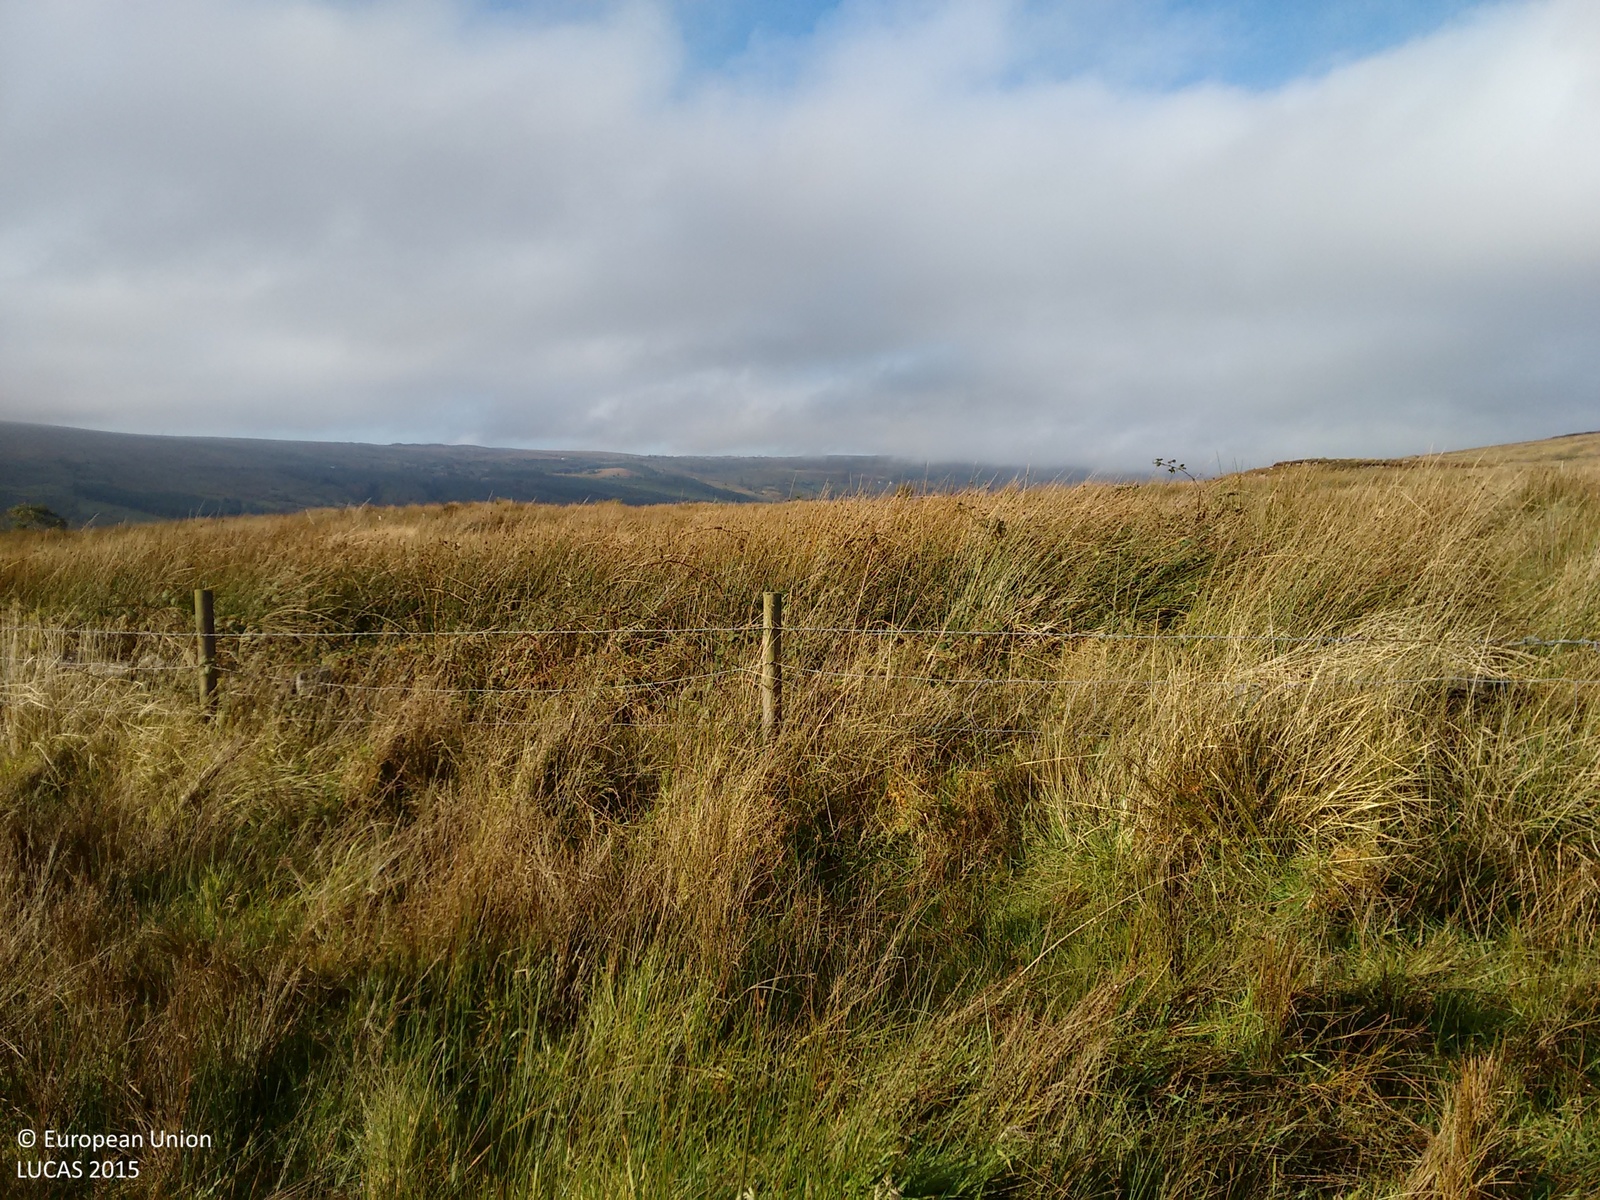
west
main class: Grassland
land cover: Grassland without tree/shrub cover
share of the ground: > 75 %
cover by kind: herbaceous plants 100 %
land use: Agriculture (excluding fallow land and kitchen gardens)
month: October
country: IE
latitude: 54.1045
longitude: -8.1180
